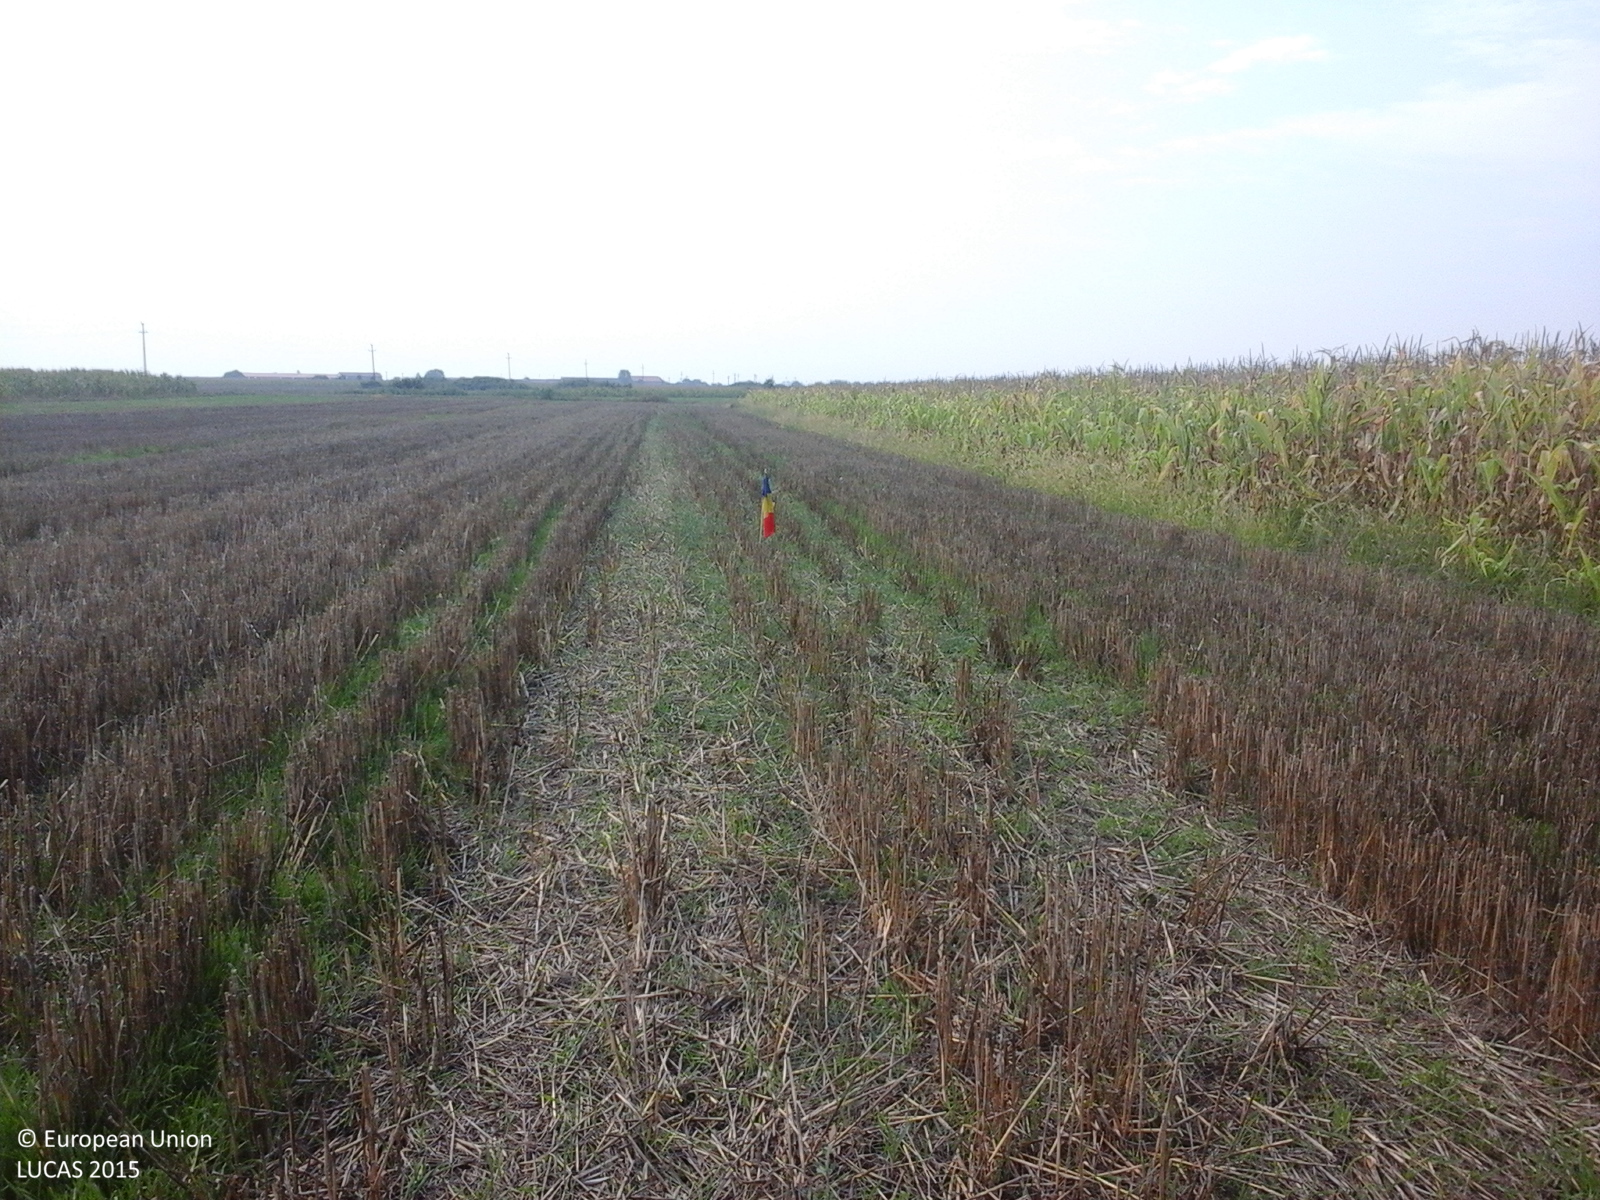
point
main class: Cropland
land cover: Durum wheat
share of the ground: > 75 %
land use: Agriculture (excluding fallow land and kitchen gardens)
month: August
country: RO
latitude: 46.5357
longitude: 21.6047
